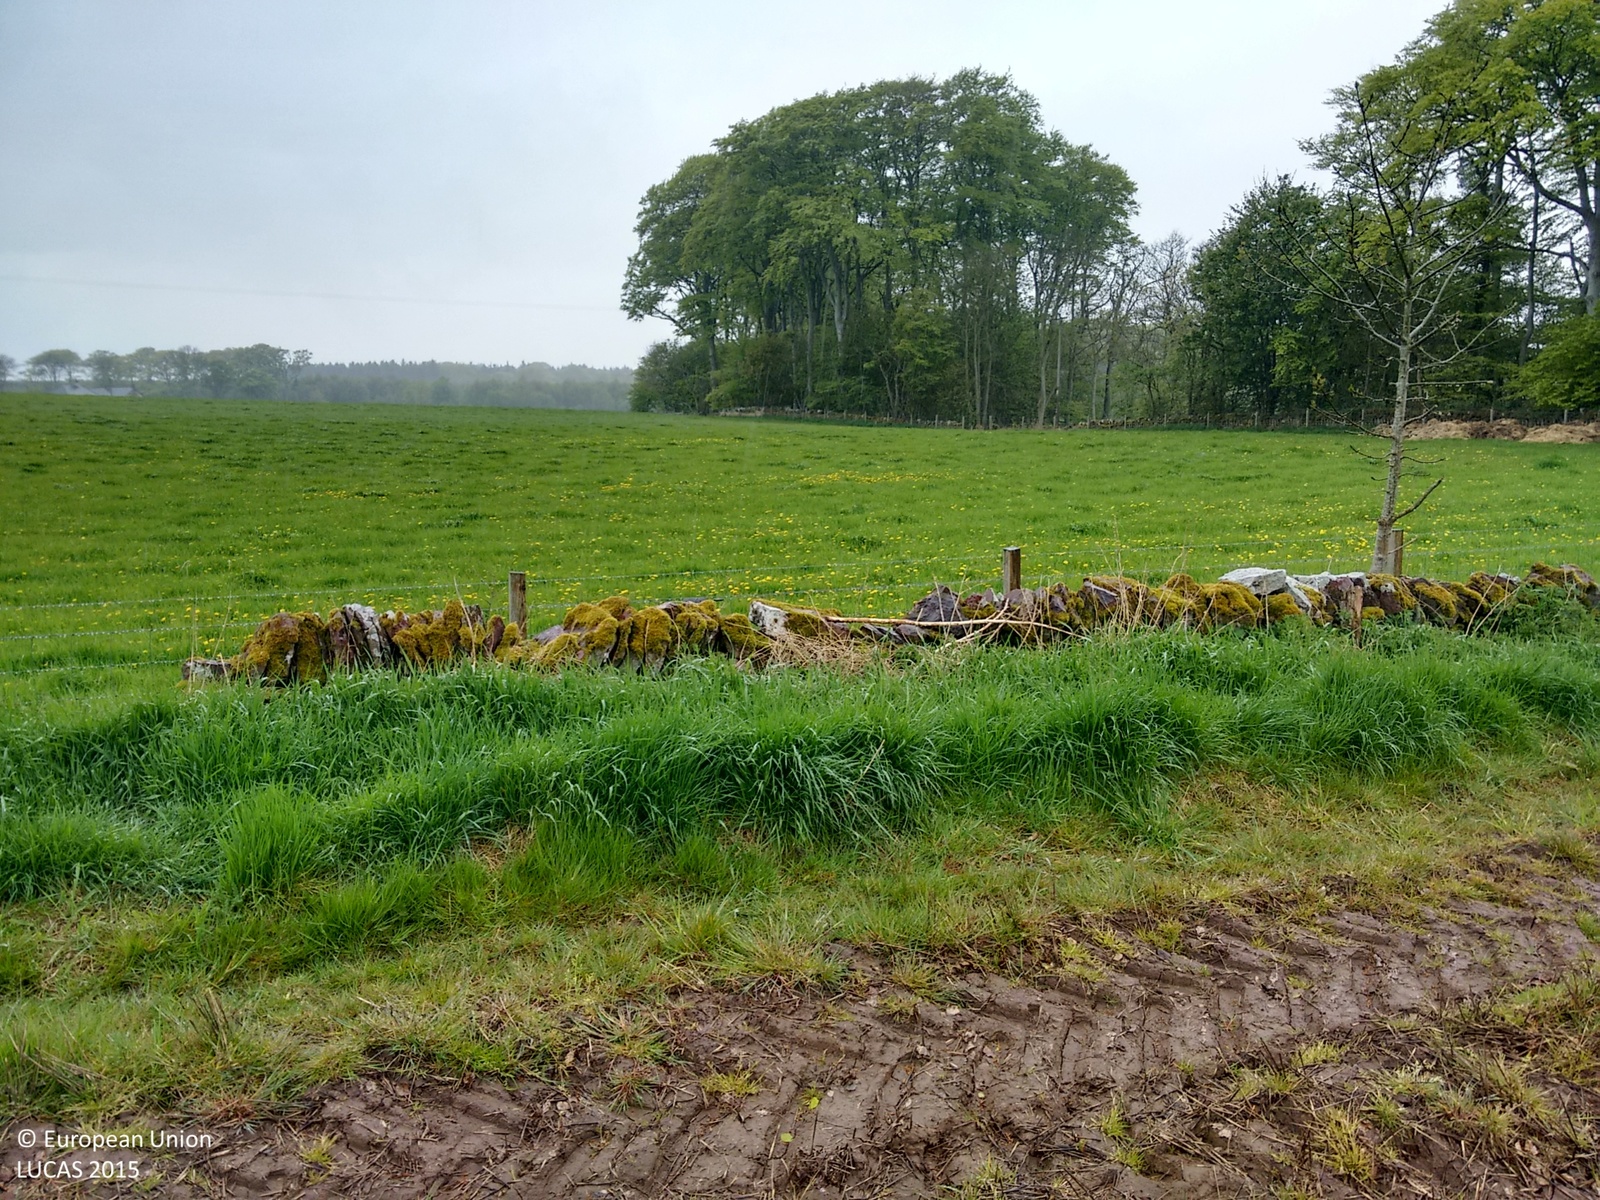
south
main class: Grassland
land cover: Spontaneously vegetated surfaces
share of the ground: 10 - 25 %
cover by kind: unconsolidated bare surface 60 %, herbaceous plants 40 %
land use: Agriculture (excluding fallow land and kitchen gardens)
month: May
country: GB
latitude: 56.6070
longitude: -2.5531
